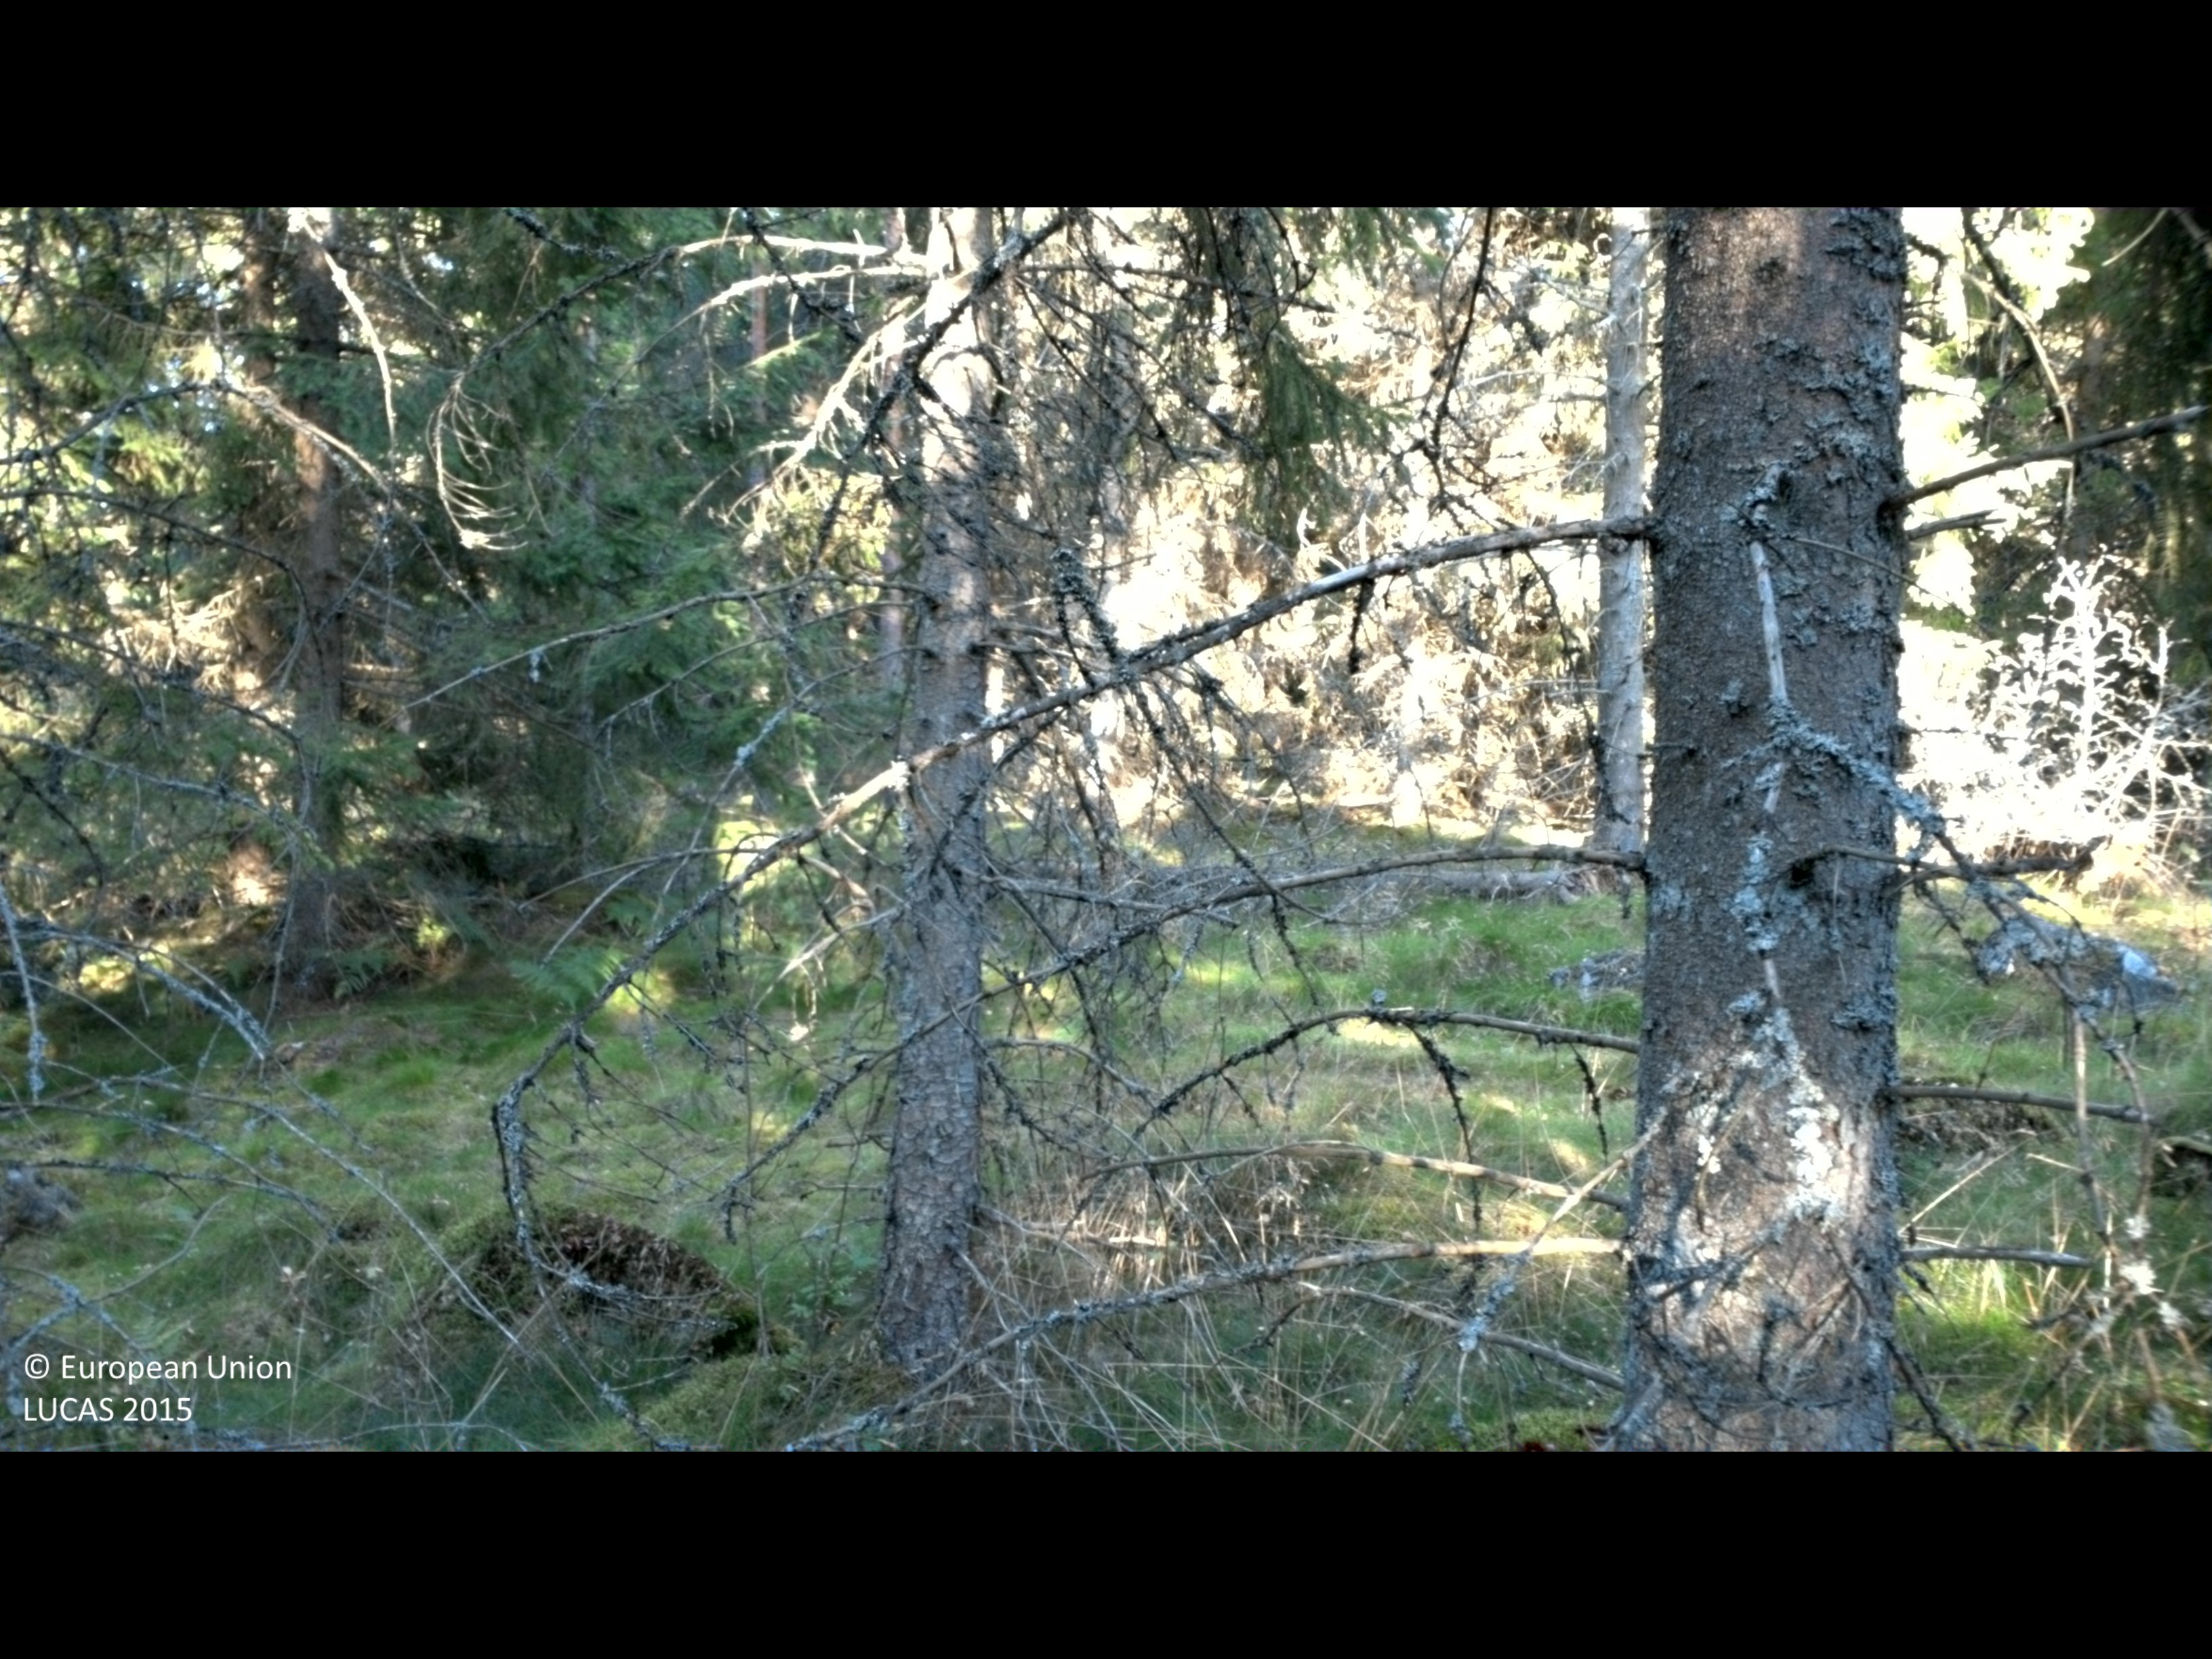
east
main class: Woodland
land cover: Spruce dominated coniferous woodland
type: boreal forest
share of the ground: 50 - 75 %
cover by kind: coniferous forest trees 55 %, herbaceous plants 20 %, lichens and mosses 20 %, broadleaved forest trees 5 %
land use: Forestry
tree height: > 5 m
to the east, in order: Spruce dominated coniferous woodland; Spruce dominated mixed woodland
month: August
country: SE
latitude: 56.2442
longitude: 15.2111
